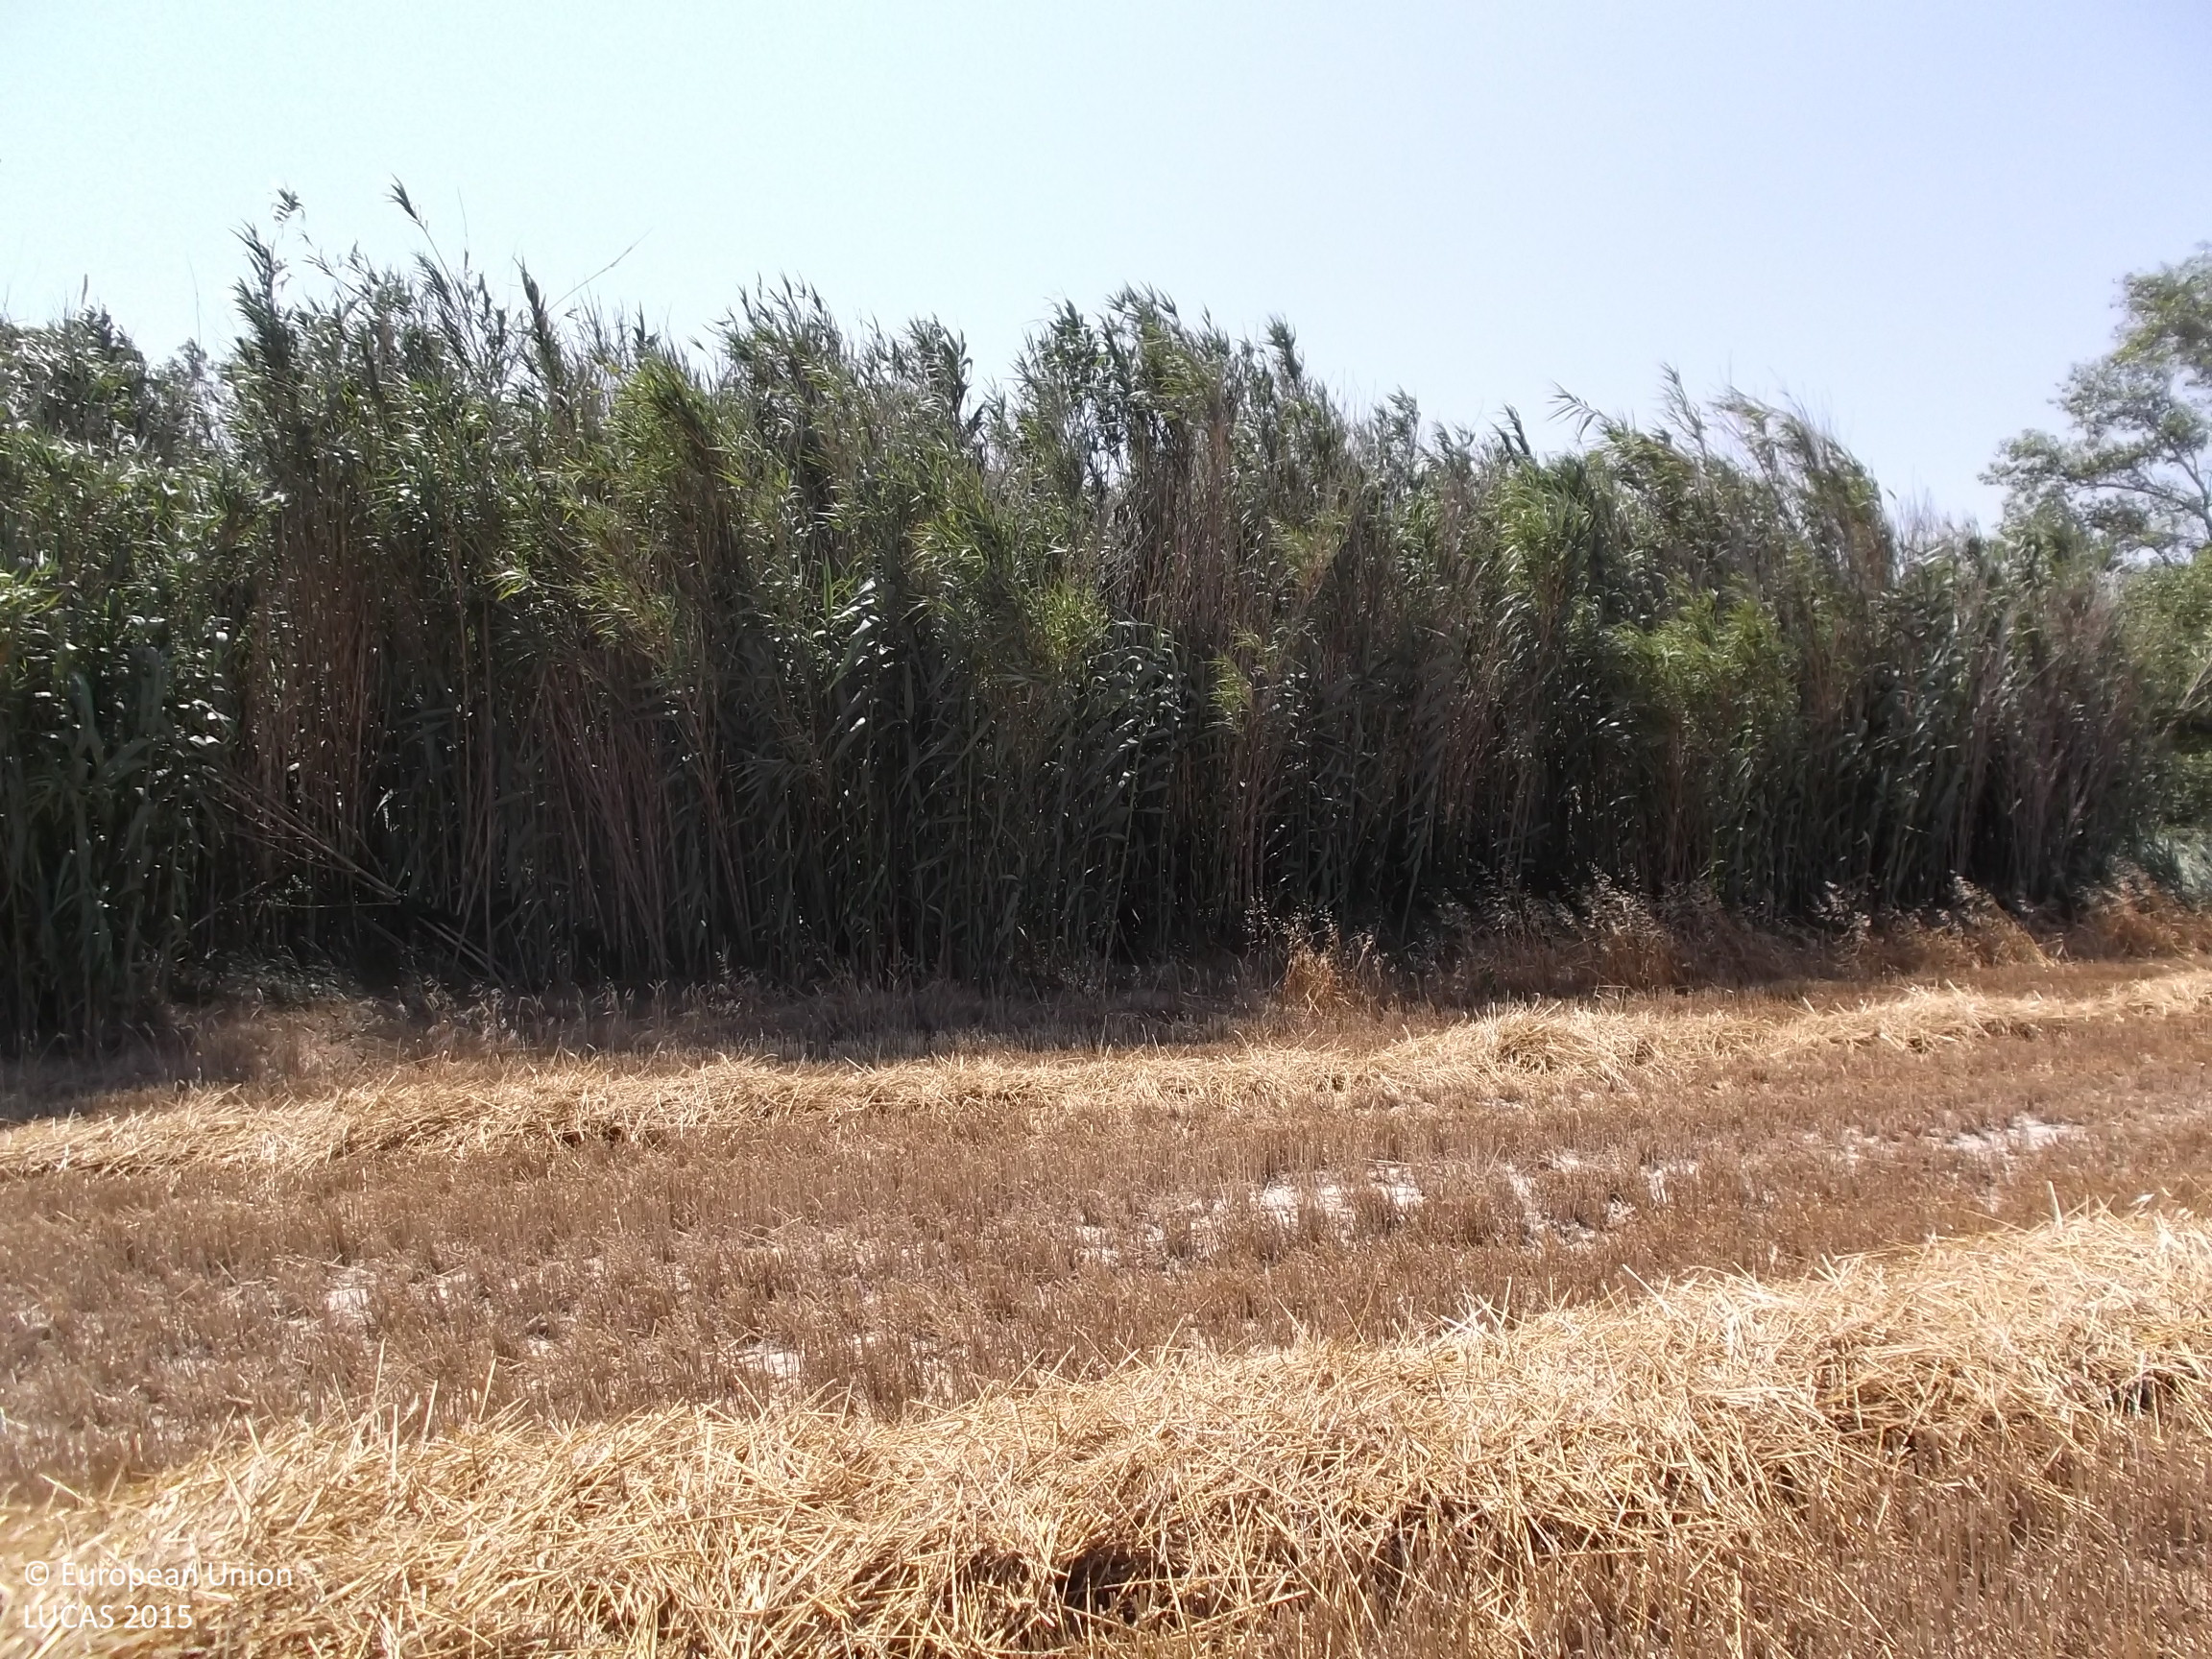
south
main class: Cropland
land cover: Common wheat
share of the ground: < 10 %
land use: Agriculture (excluding fallow land and kitchen gardens)
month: July
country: ES
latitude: 42.3699
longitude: -1.5828
